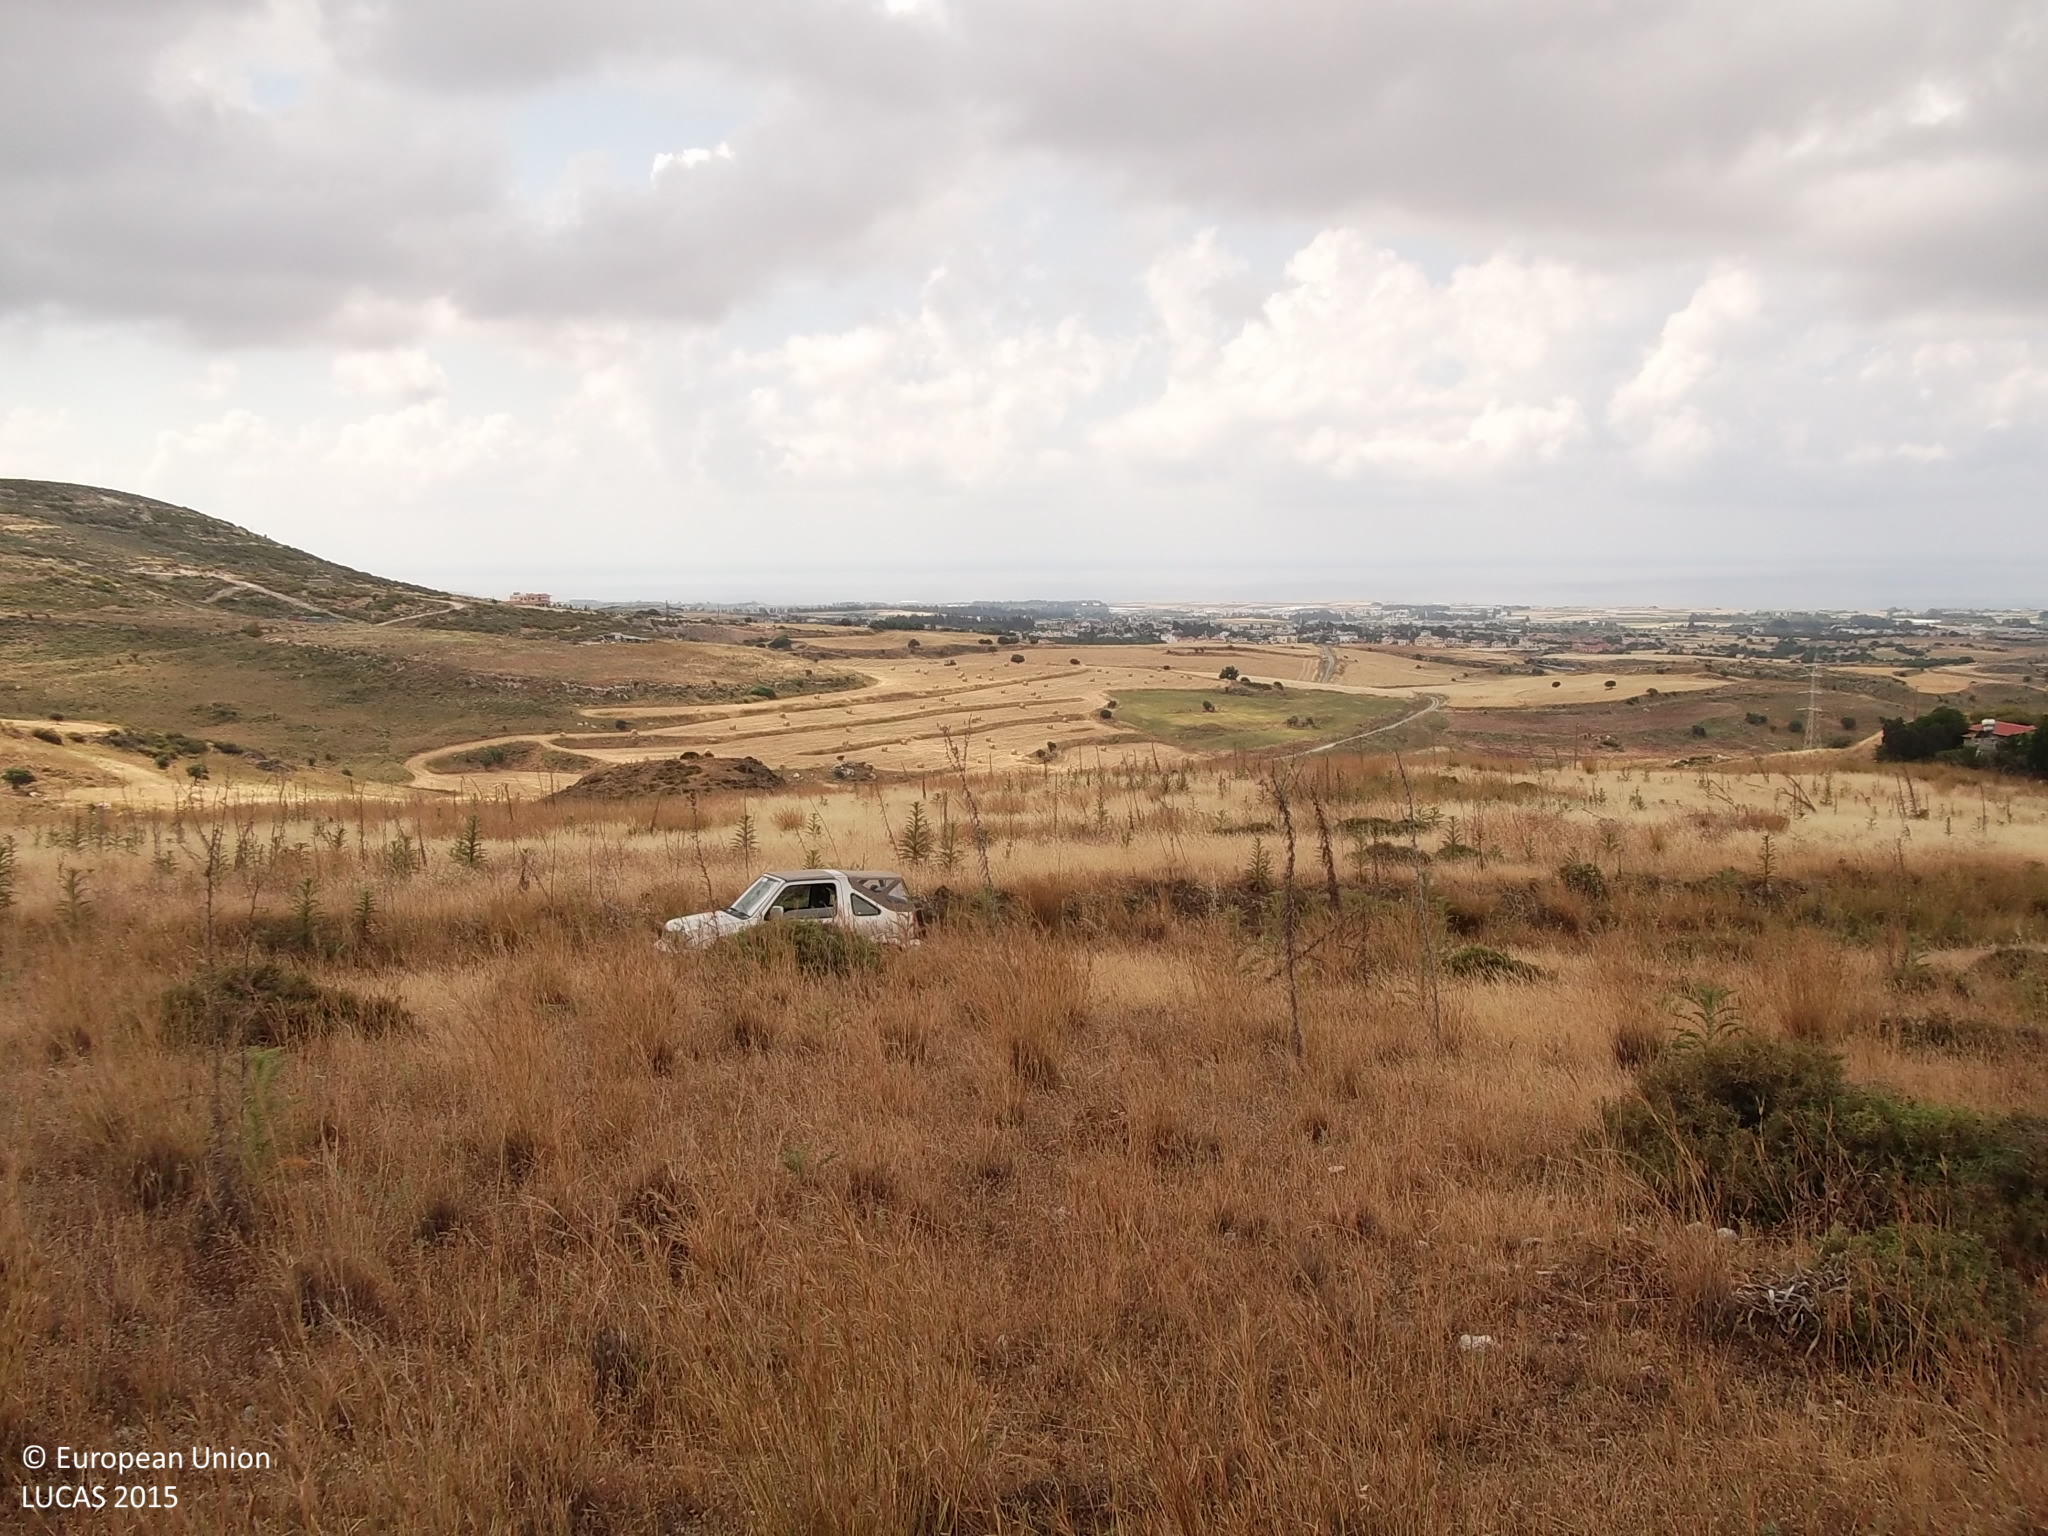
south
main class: Shrubland
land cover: Shrubland without tree cover
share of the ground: 25 - 50 %
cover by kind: herbaceous plants 50 %, shrubs 30 %, unconsolidated bare surface 20 %
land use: Semi-natural and natural areas not in use
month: May
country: CY
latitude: 34.7620
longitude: 32.5341
